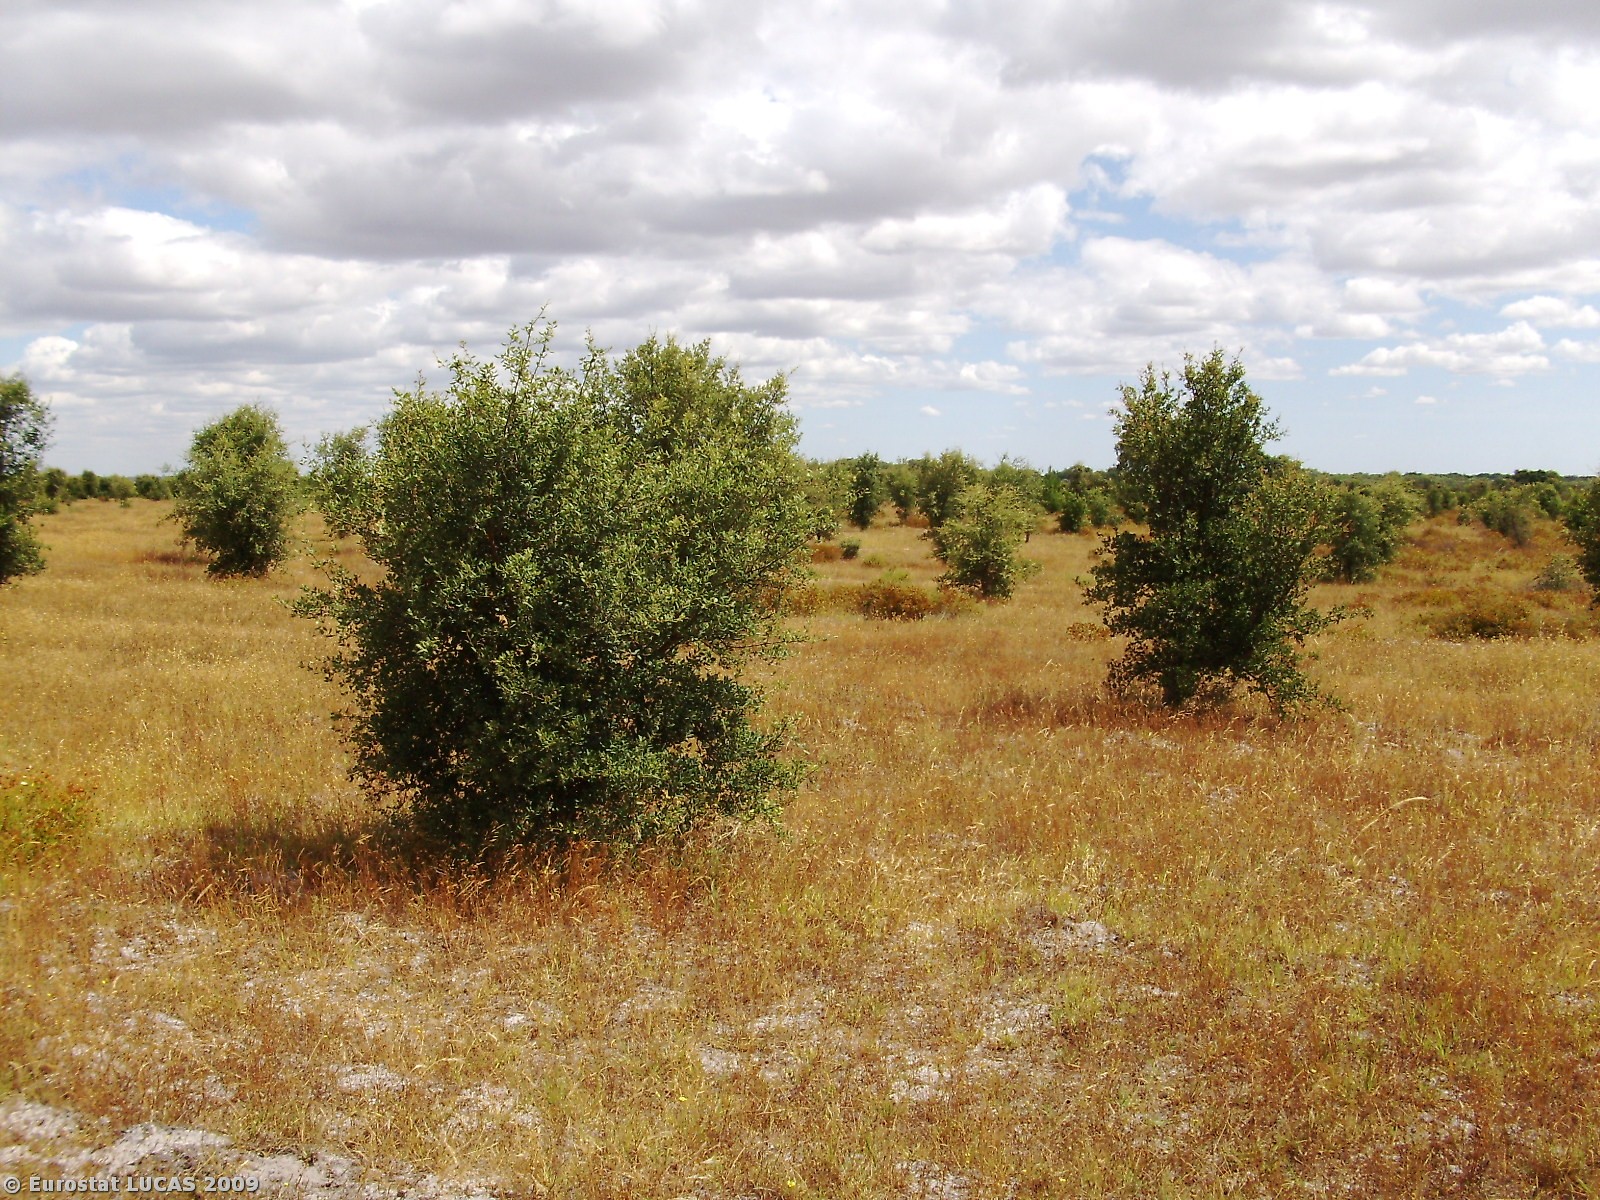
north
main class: Woodland
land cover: Broadleaved woodland
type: broadleaved evergreen forest
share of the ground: 10 - 25 %
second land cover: Spontaneously vegetated surfaces
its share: > 75 %
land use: Forestry
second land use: Fallow land
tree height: > 5 m
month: June
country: PT
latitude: 37.9817
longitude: -8.4511
